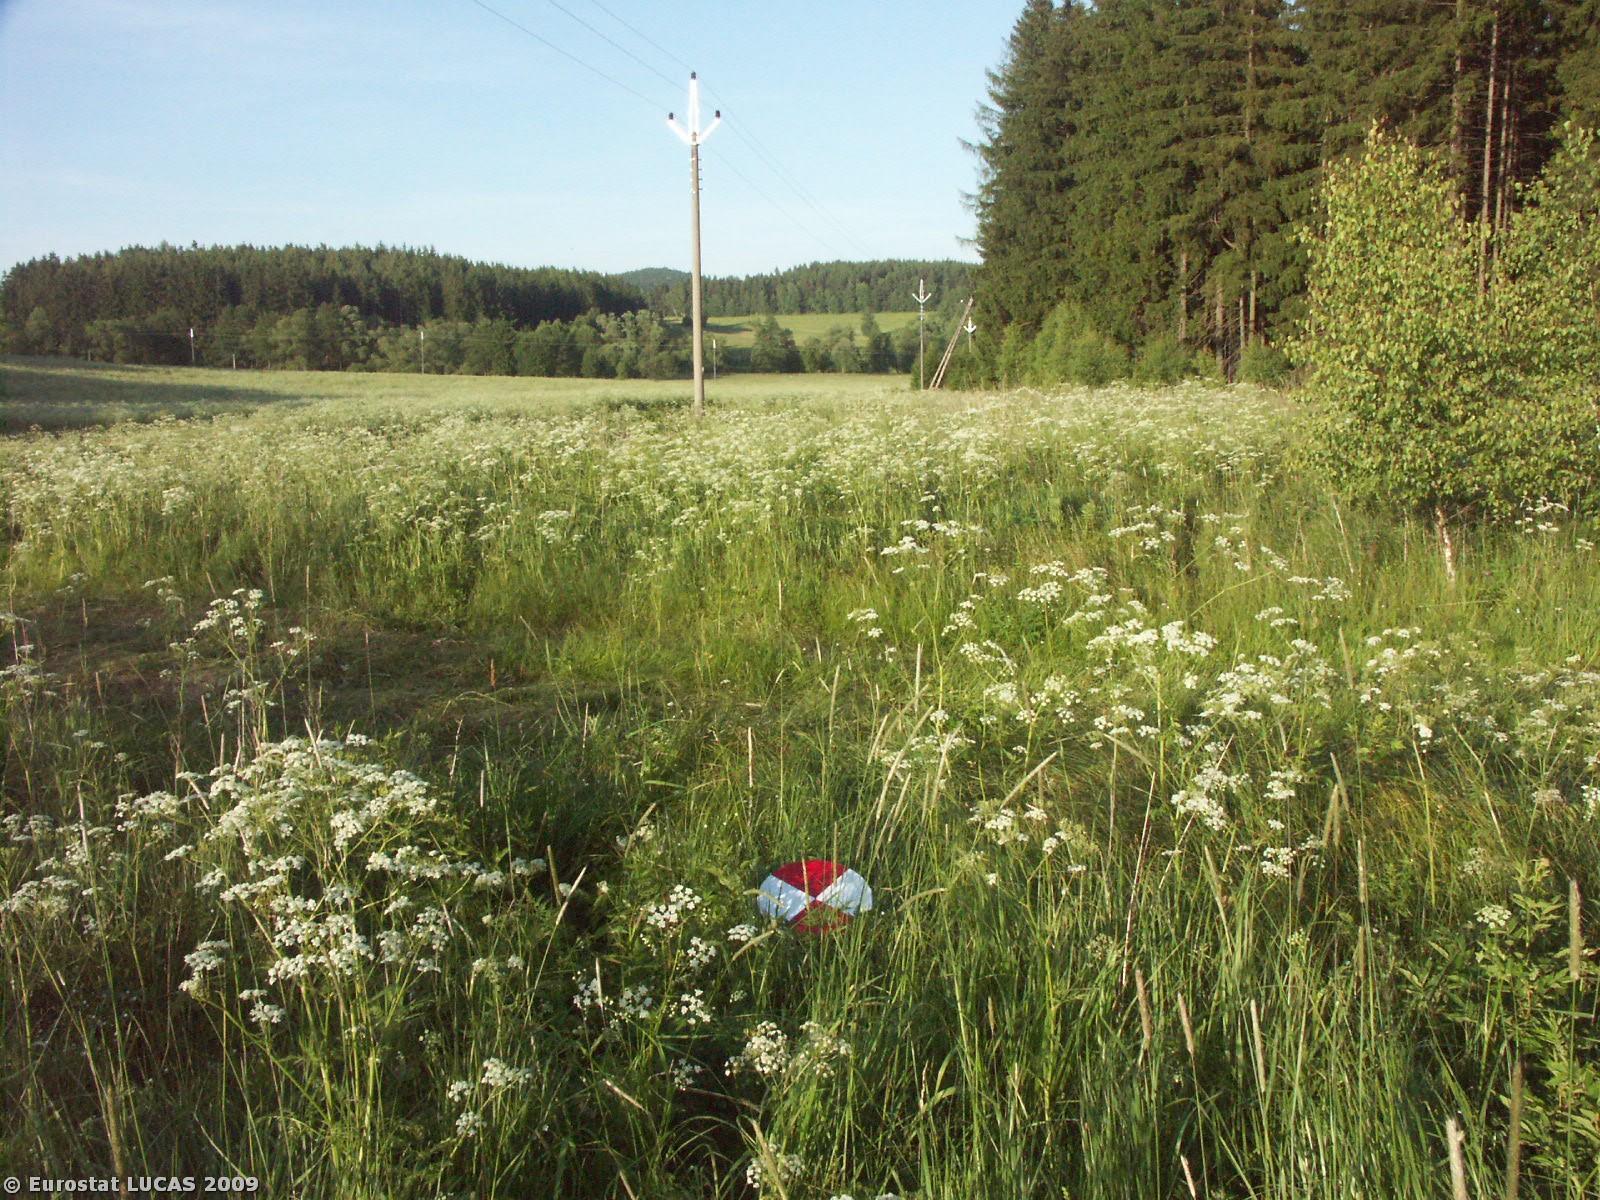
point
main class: Grassland
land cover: Grassland without tree/shrub cover
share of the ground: > 75 %
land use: Unused
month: June
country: CZ
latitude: 48.6452
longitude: 14.2758
